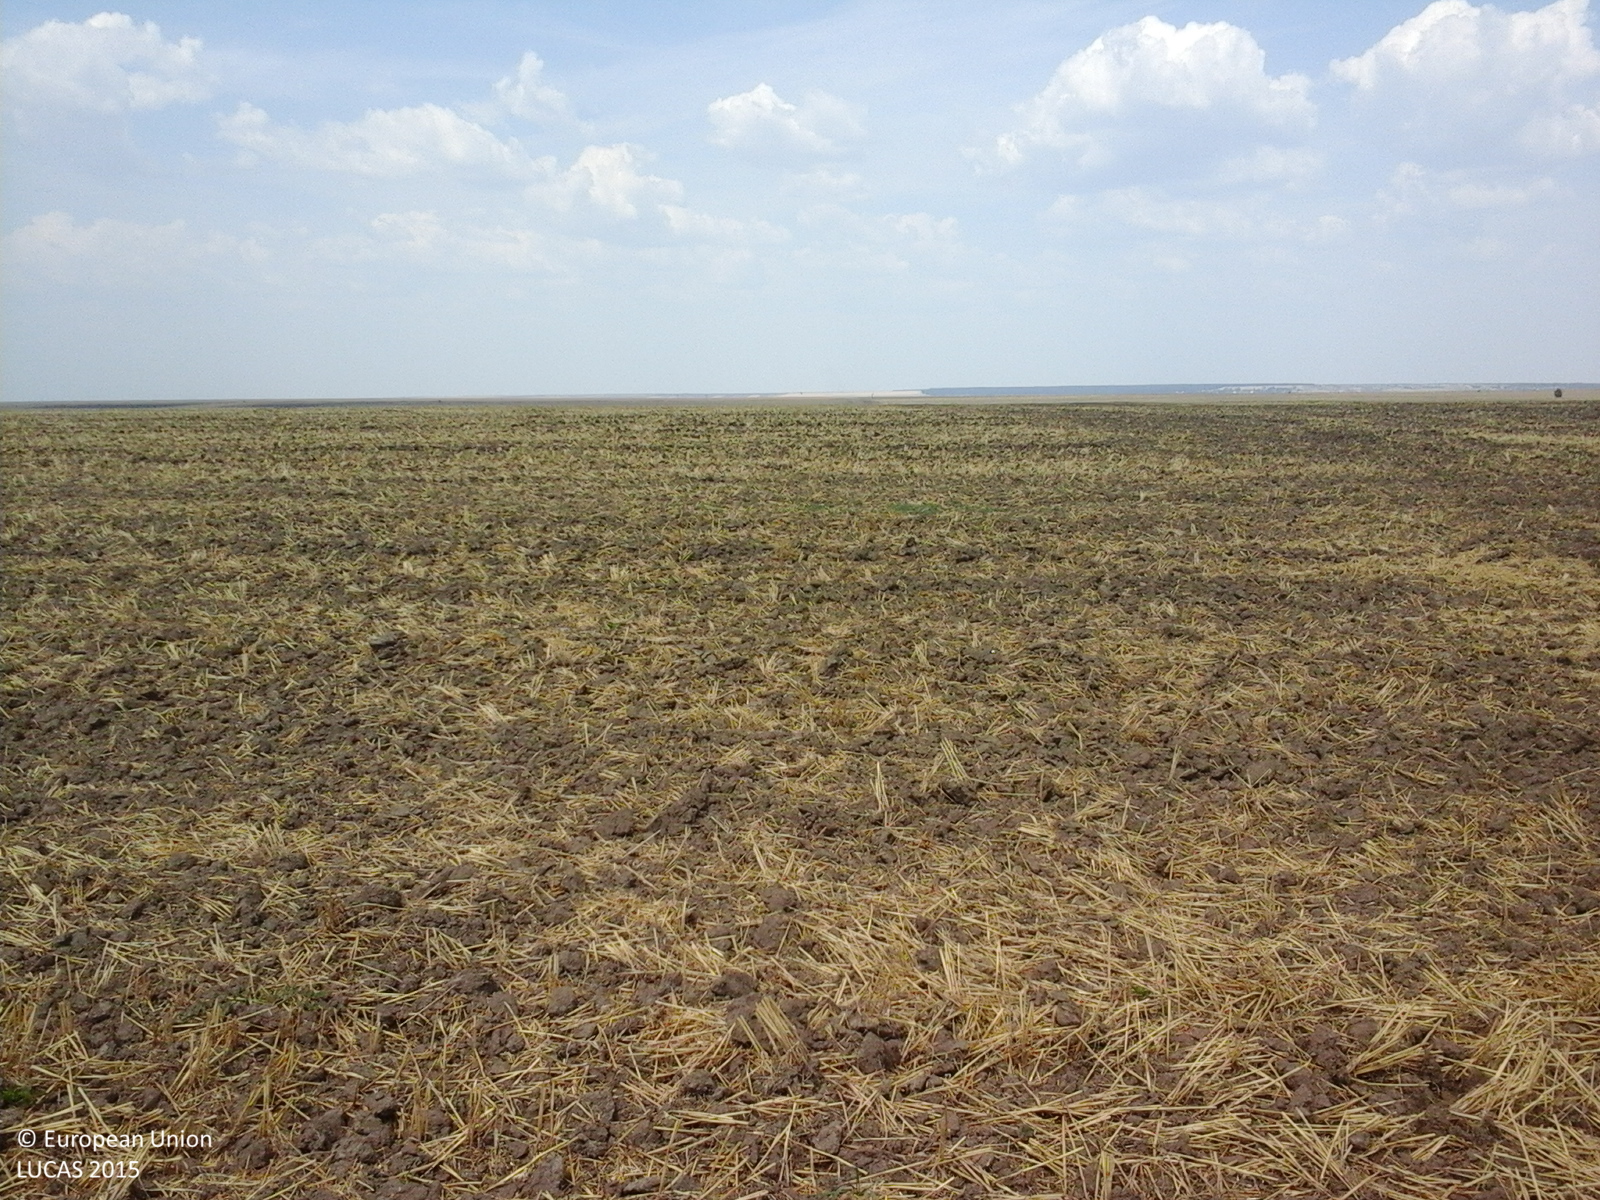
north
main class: Cropland
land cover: Common wheat
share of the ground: 25 - 50 %
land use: Agriculture (excluding fallow land and kitchen gardens)
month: August
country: RO
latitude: 44.1536
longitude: 23.1102
